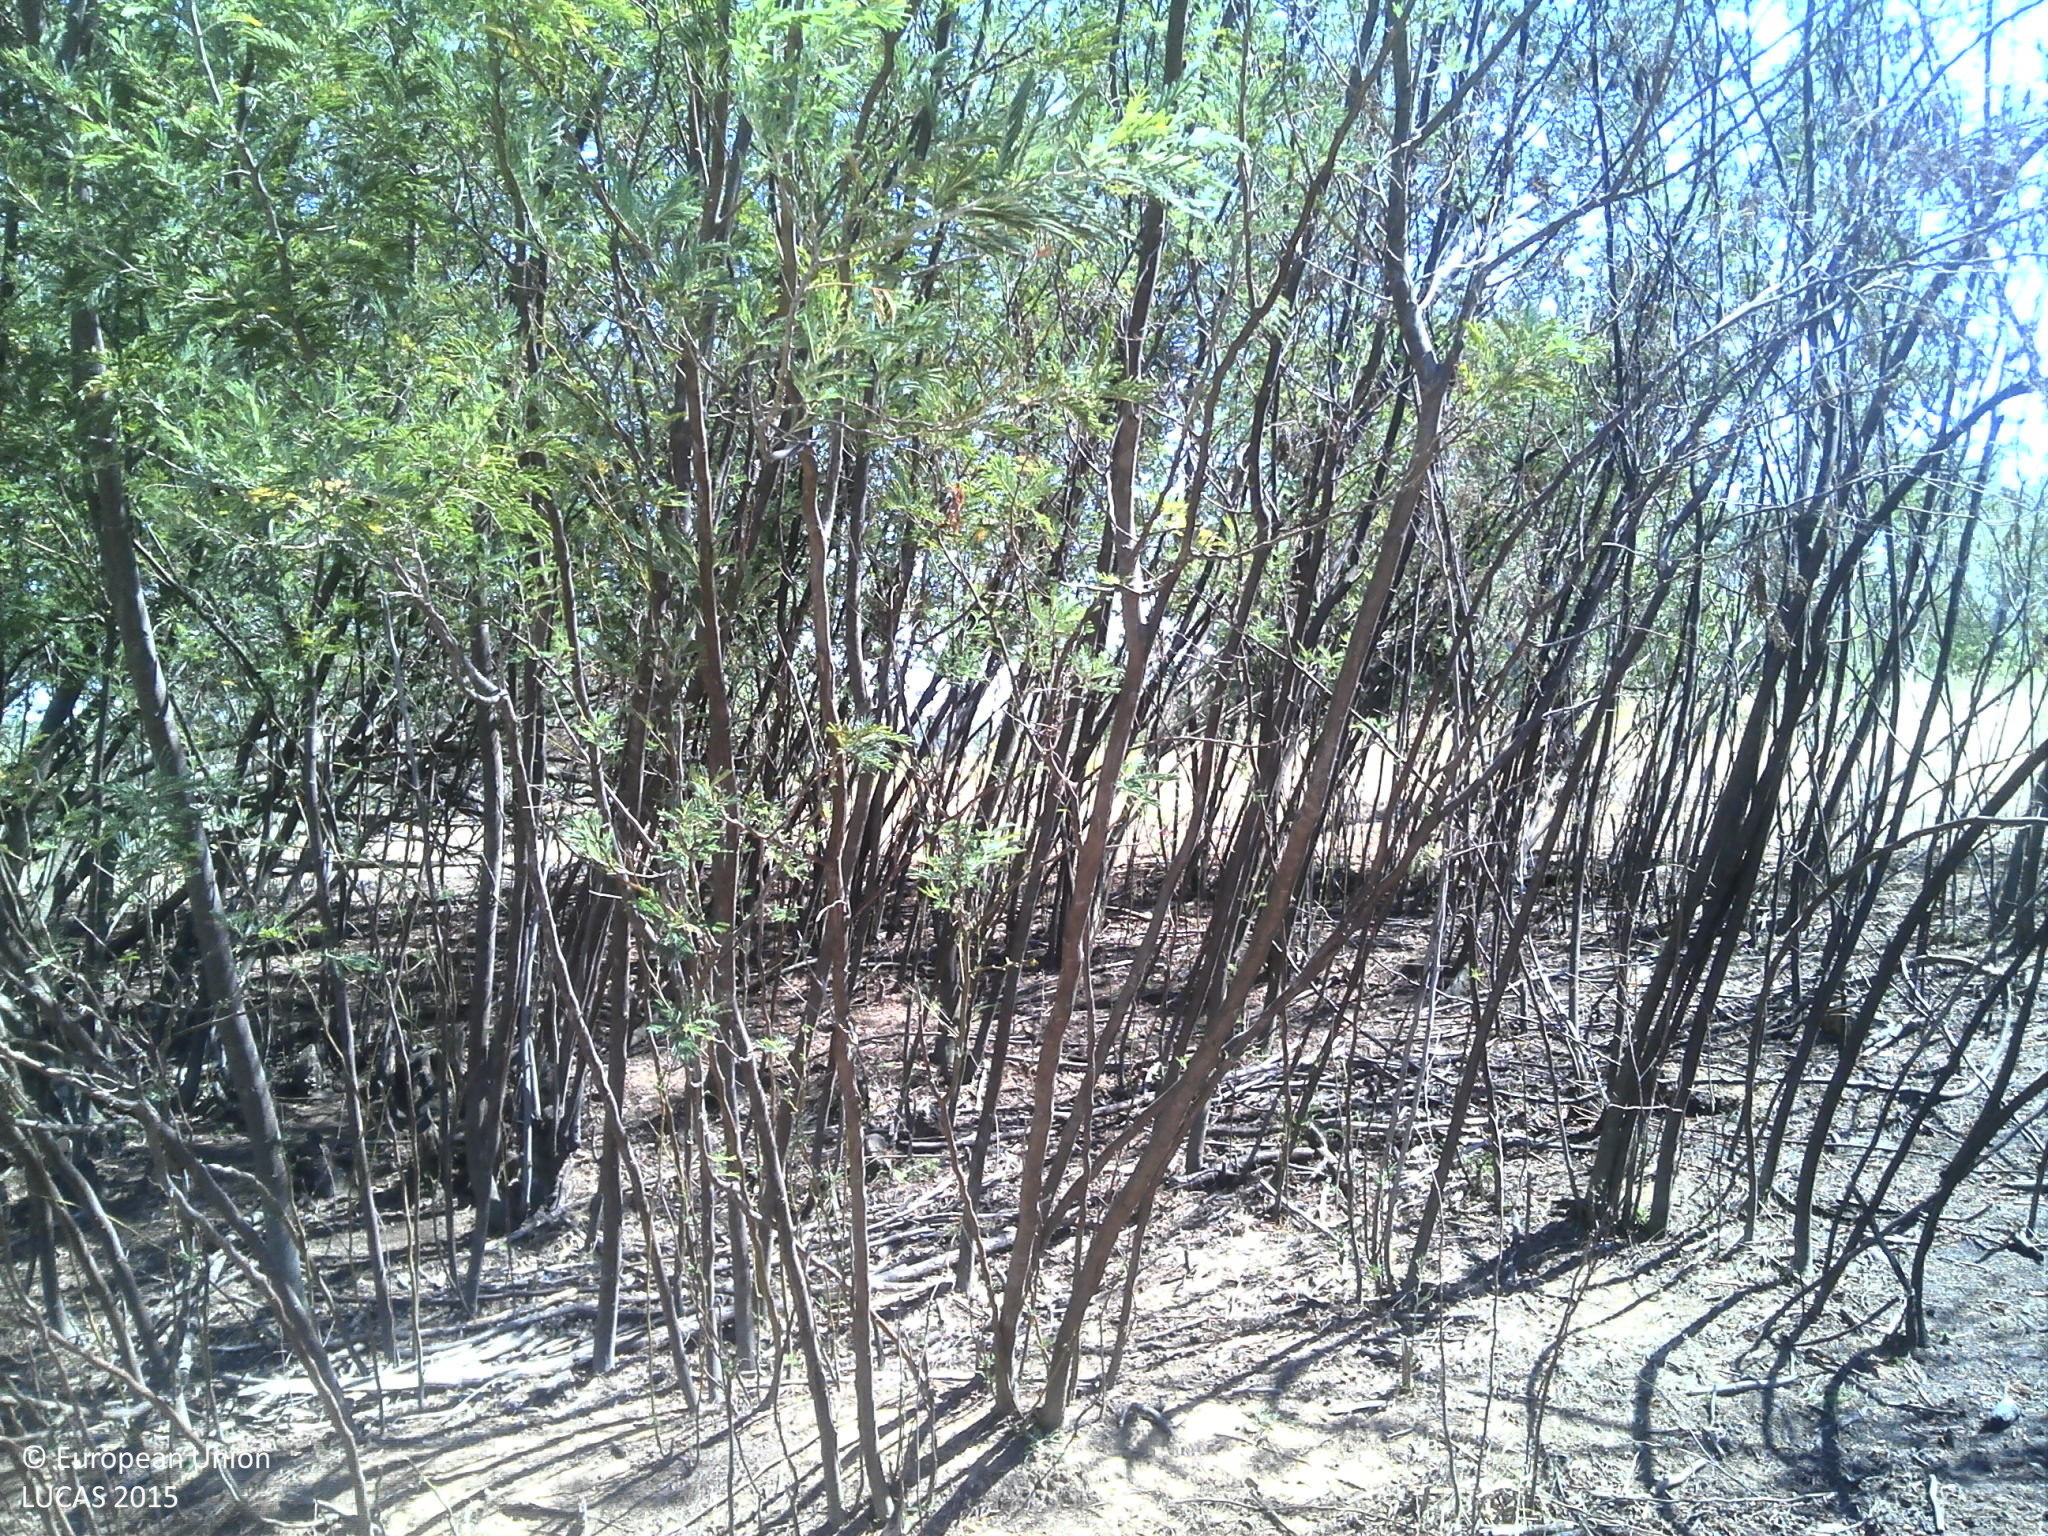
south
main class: Cropland
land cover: Olive groves
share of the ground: 25 - 50 %
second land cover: Grassland without tree/shrub cover
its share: 25 - 50 %
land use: Agriculture (excluding fallow land and kitchen gardens)
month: June
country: PT
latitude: 40.0768
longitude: -7.2294
